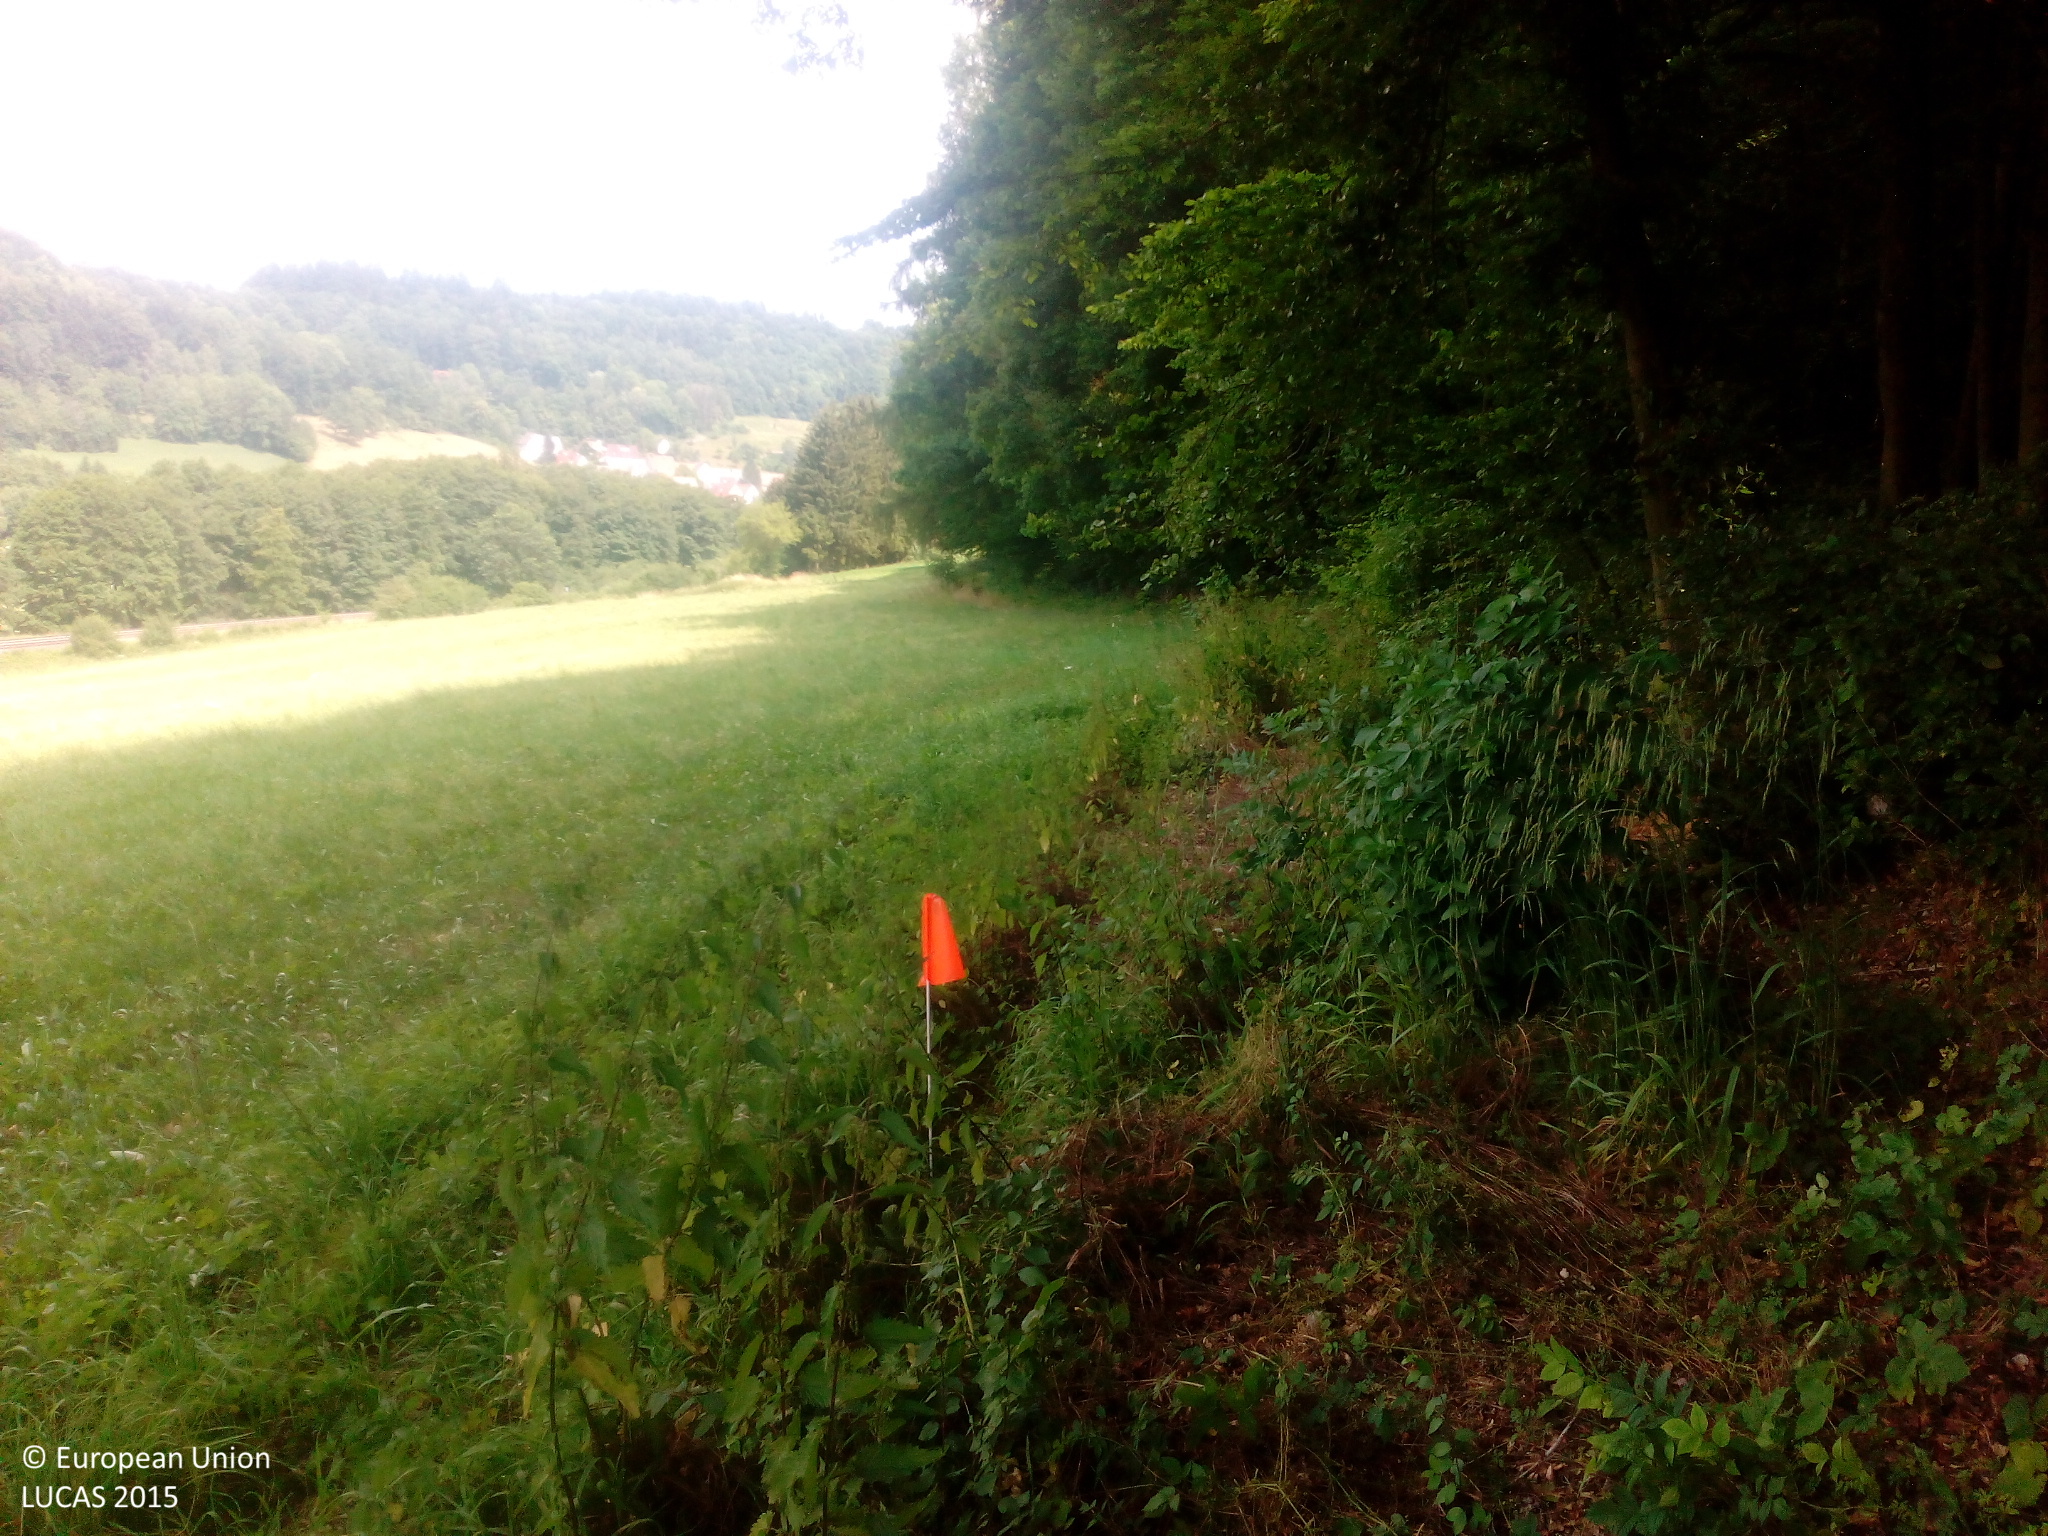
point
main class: Grassland
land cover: Grassland without tree/shrub cover
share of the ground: > 75 %
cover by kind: herbaceous plants 95 %, unconsolidated bare surface 5 %
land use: Agriculture (excluding fallow land and kitchen gardens)
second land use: Amenities, museums, leisure
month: July
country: DE
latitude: 49.5451
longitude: 11.4784
